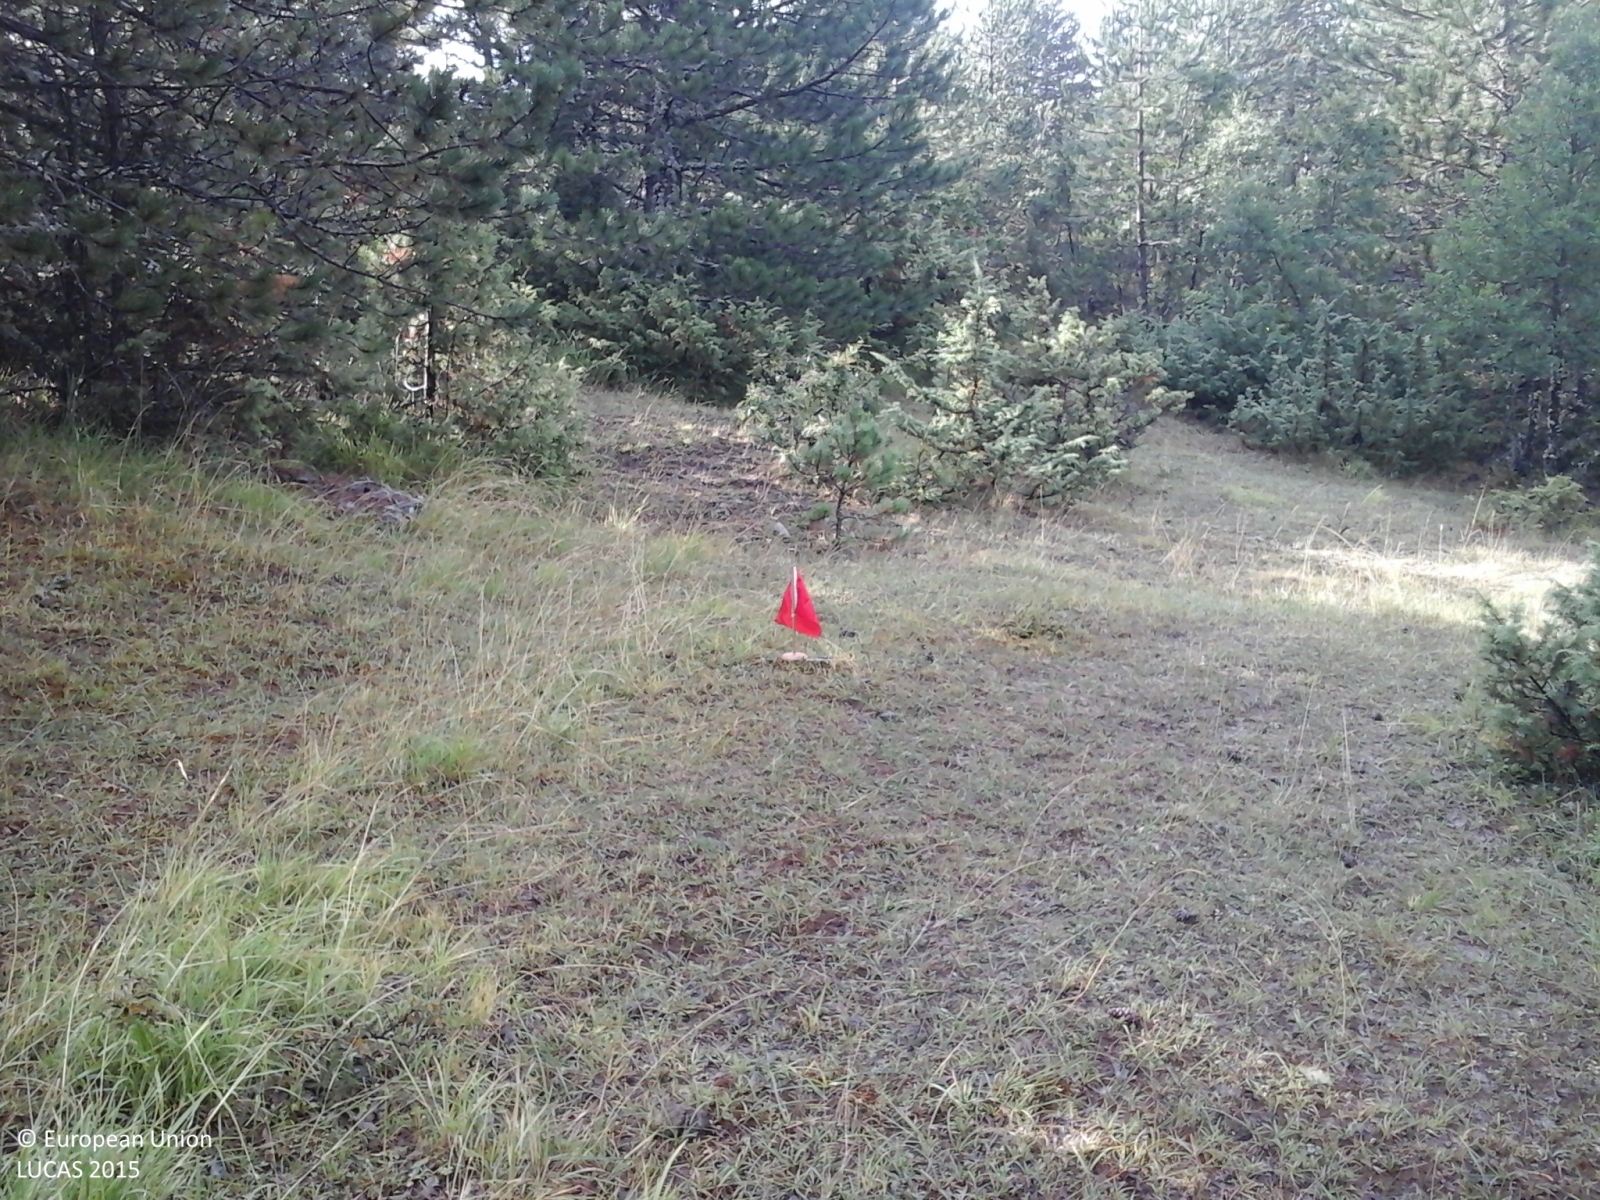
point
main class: Woodland
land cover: Pine dominated mixed woodland
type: coniferous forest of the mediterranean region
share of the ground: 50 - 75 %
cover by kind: coniferous forest trees 45 %, broadleaved forest trees 25 %, herbaceous plants 20 %, shrubs 5 %, unconsolidated bare surface 5 %
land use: Forestry
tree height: > 5 m
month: August
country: GR
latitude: 40.1746
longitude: 21.0116
